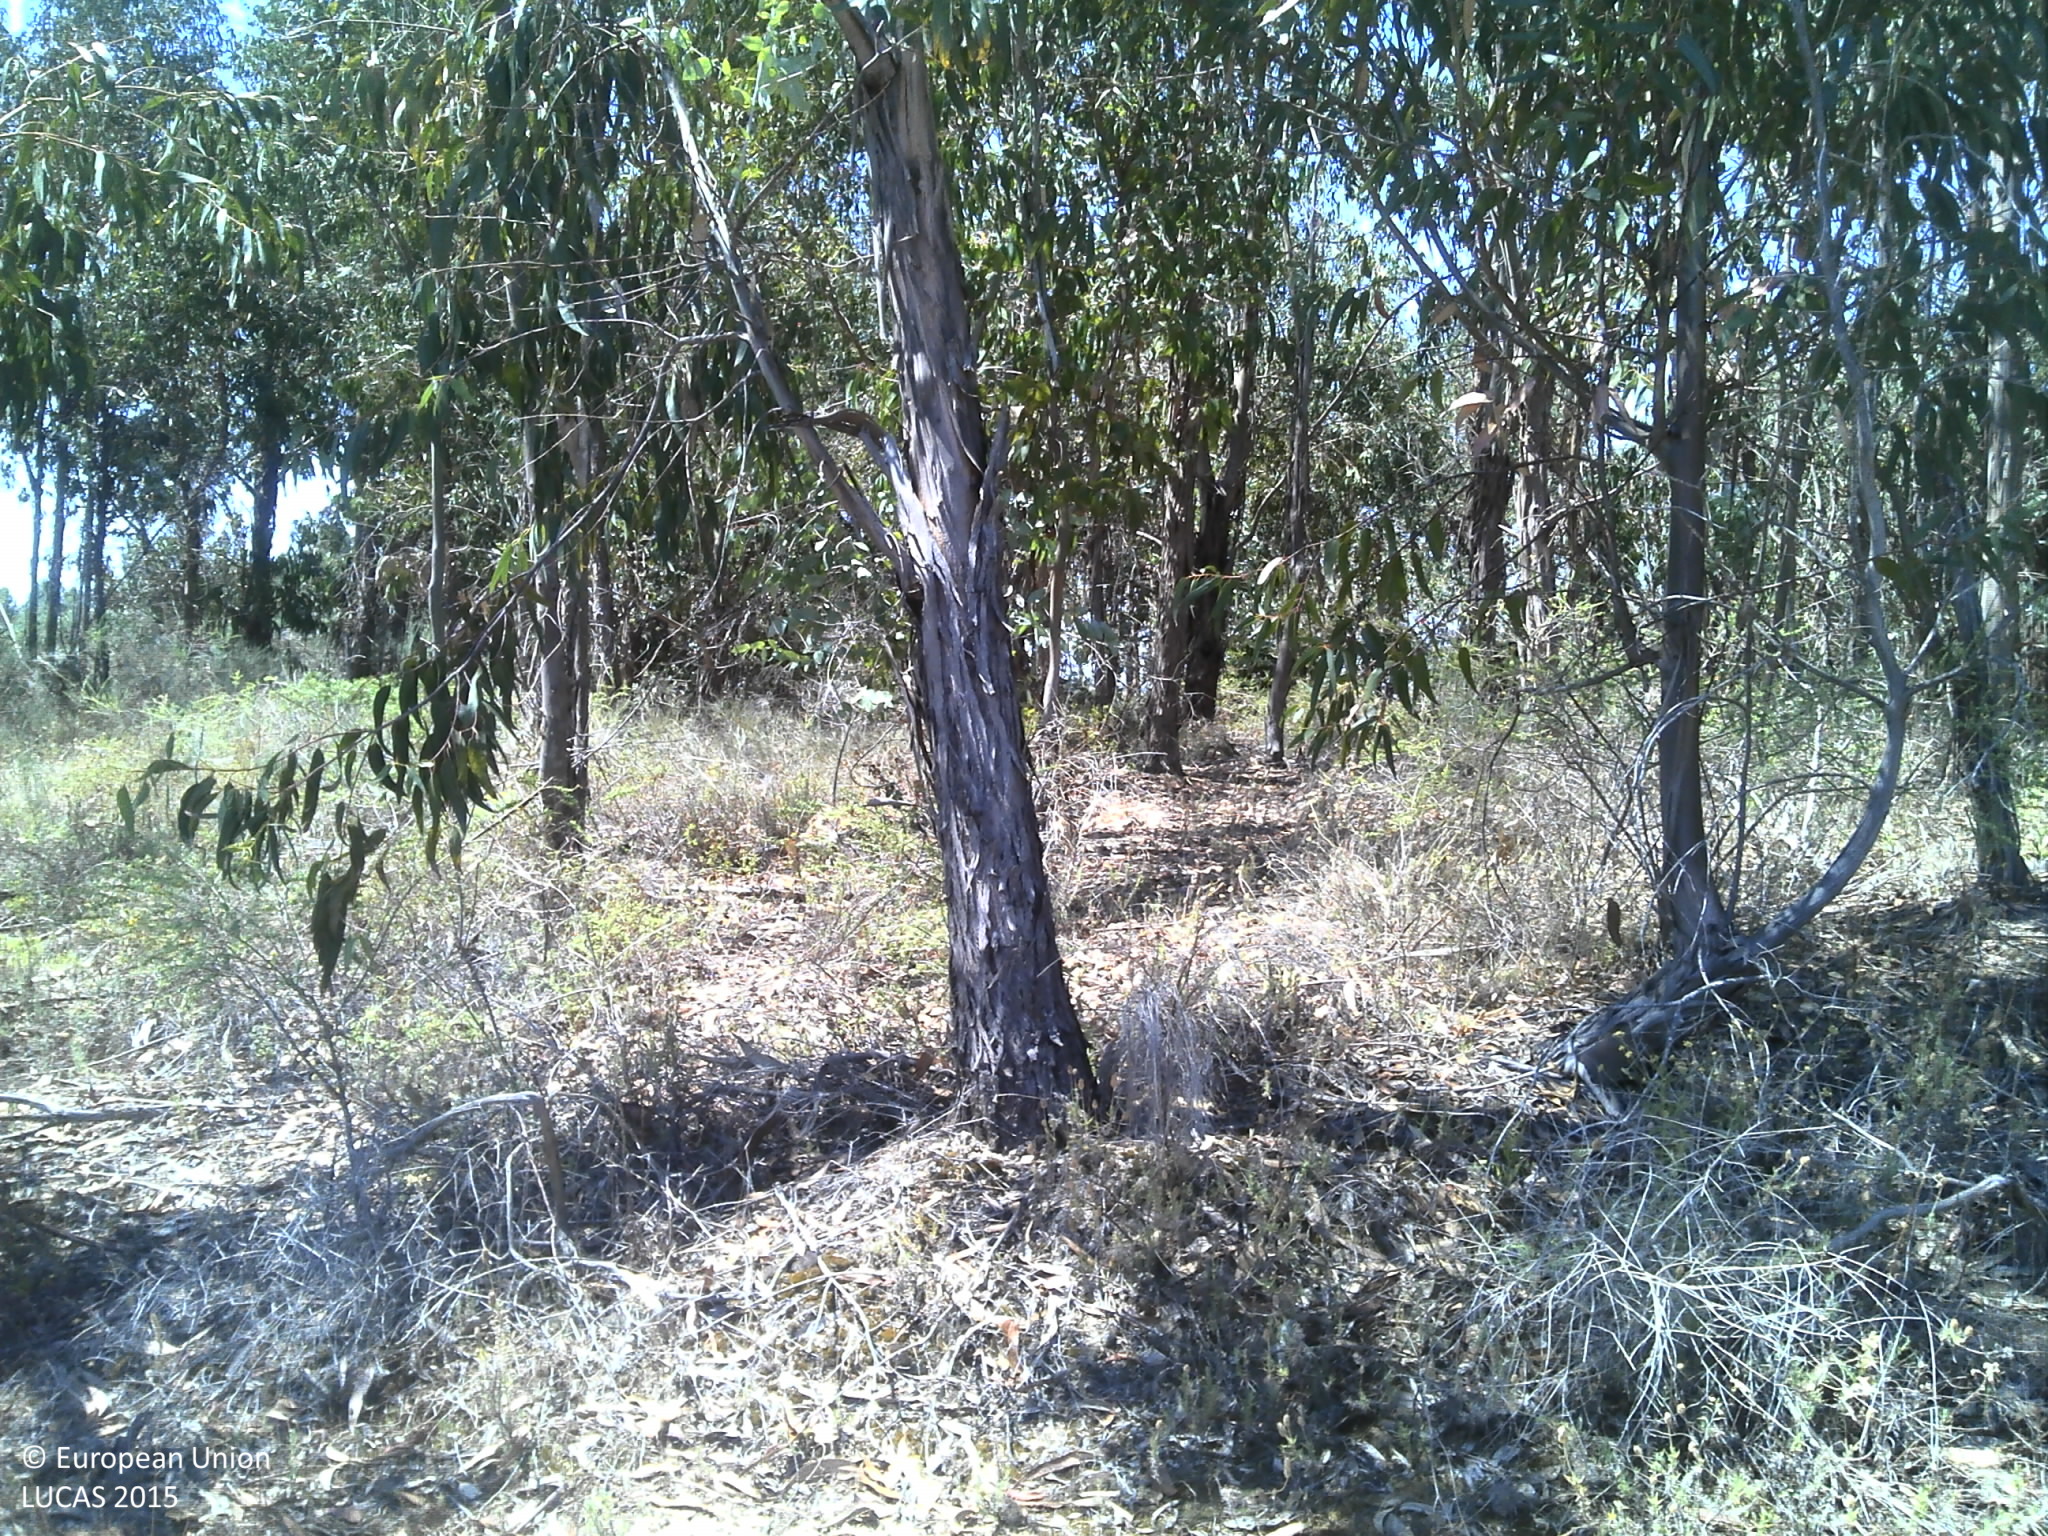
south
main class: Woodland
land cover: Broadleaved woodland
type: exotic forest
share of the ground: 25 - 50 %
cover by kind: broadleaved forest trees 50 %, shrubs 20 %, unconsolidated bare surface 15 %, herbaceous plants 10 %
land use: Forestry
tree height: > 5 m
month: June
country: PT
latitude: 40.0469
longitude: -7.2933
